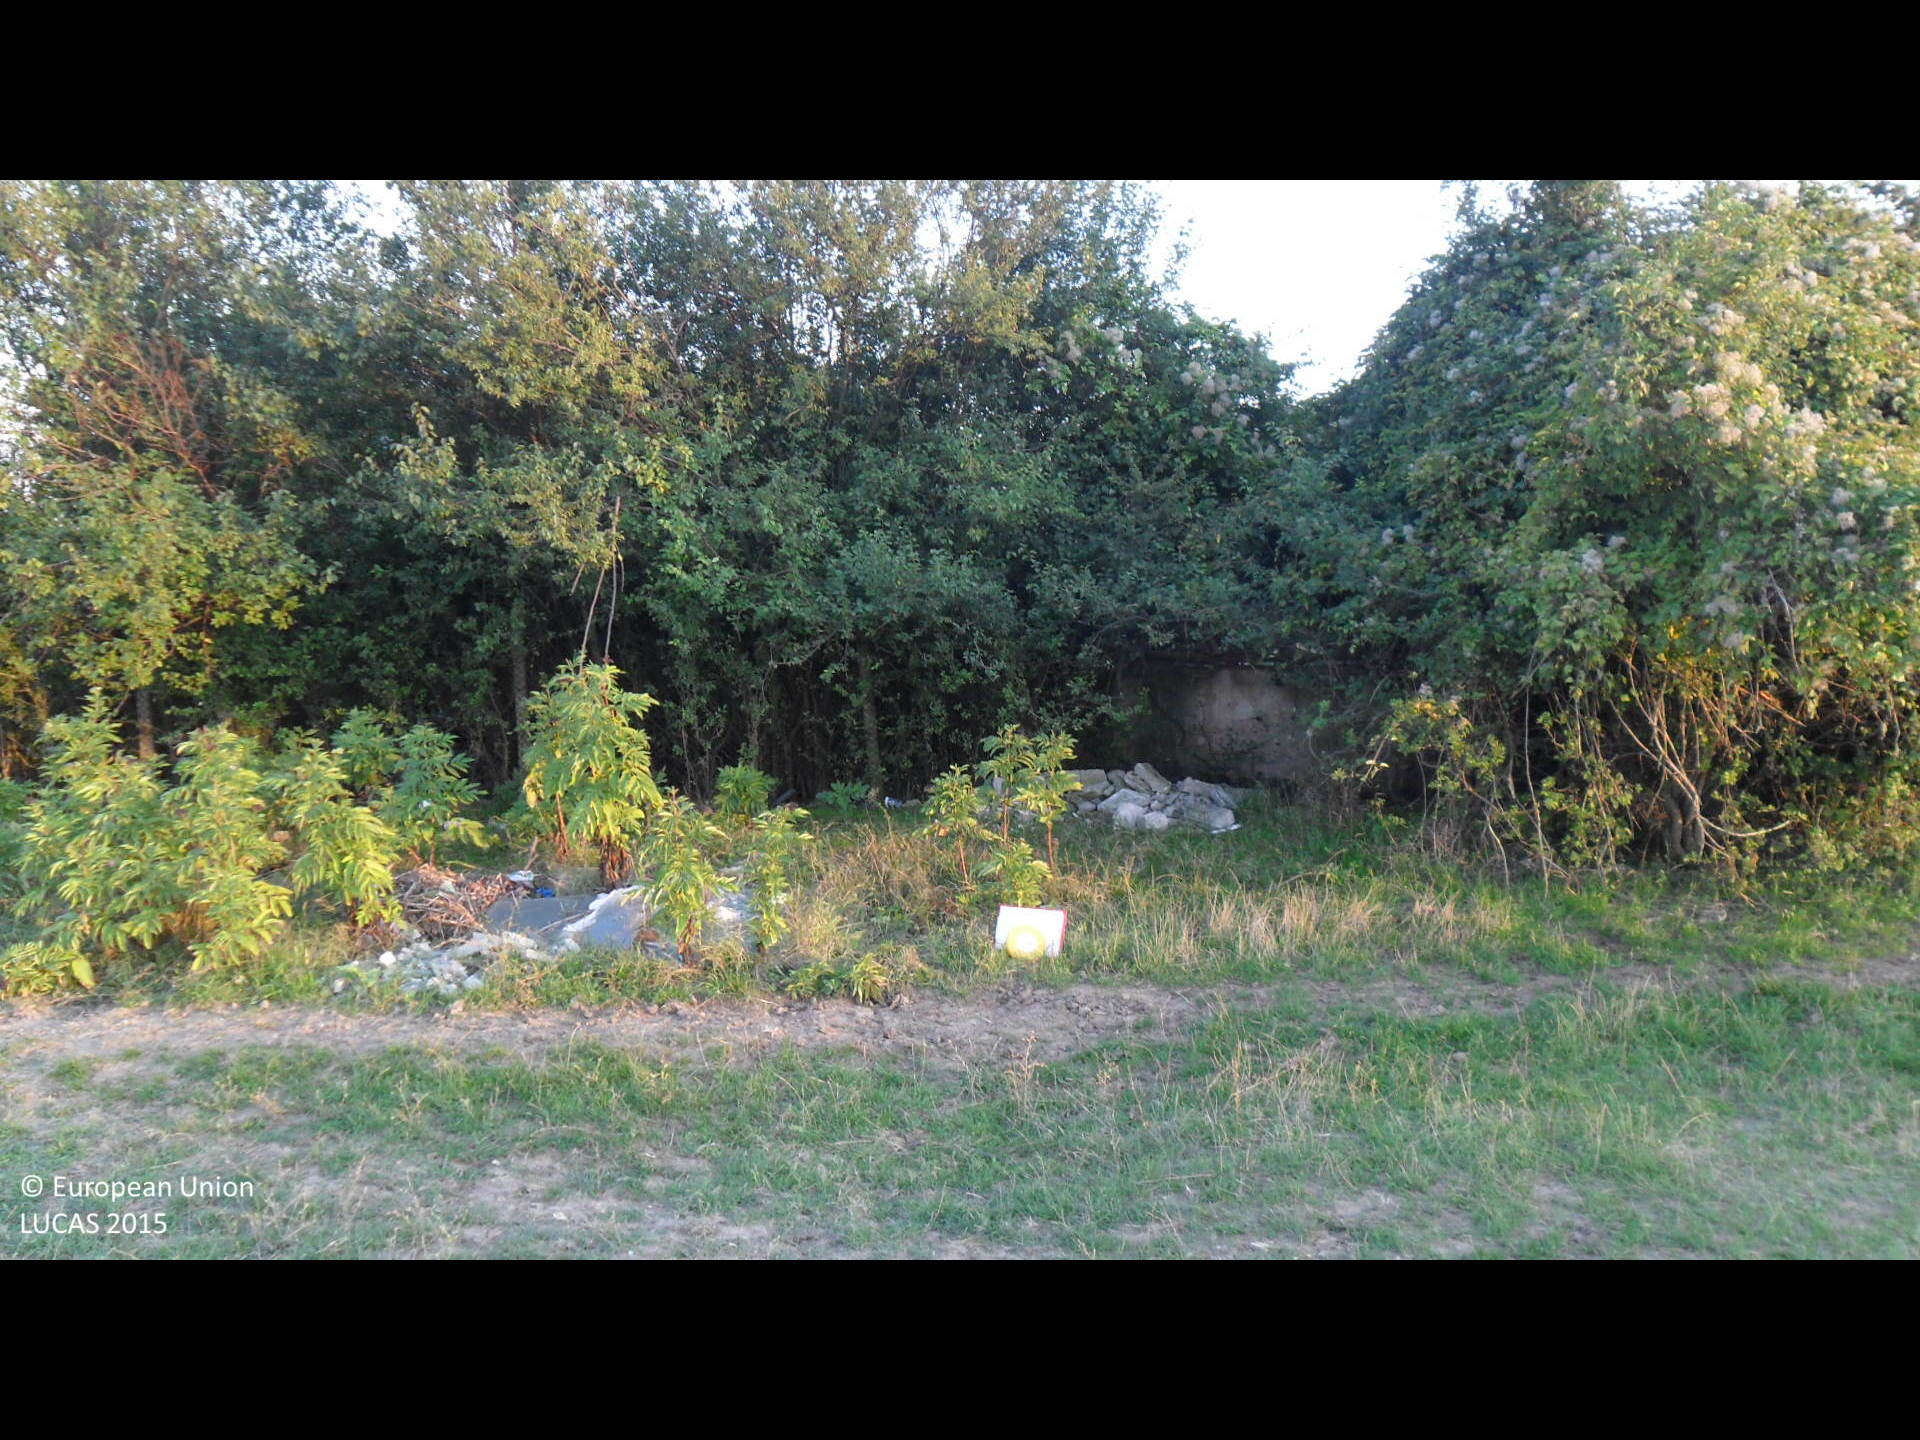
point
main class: Grassland
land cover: Grassland with sparse tree/shrub cover
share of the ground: > 75 %
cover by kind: herbaceous plants 90 %, broadleaved forest trees 5 %, shrubs 5 %
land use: Abandoned areas
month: August
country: BG
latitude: 43.2422
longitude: 26.5939
